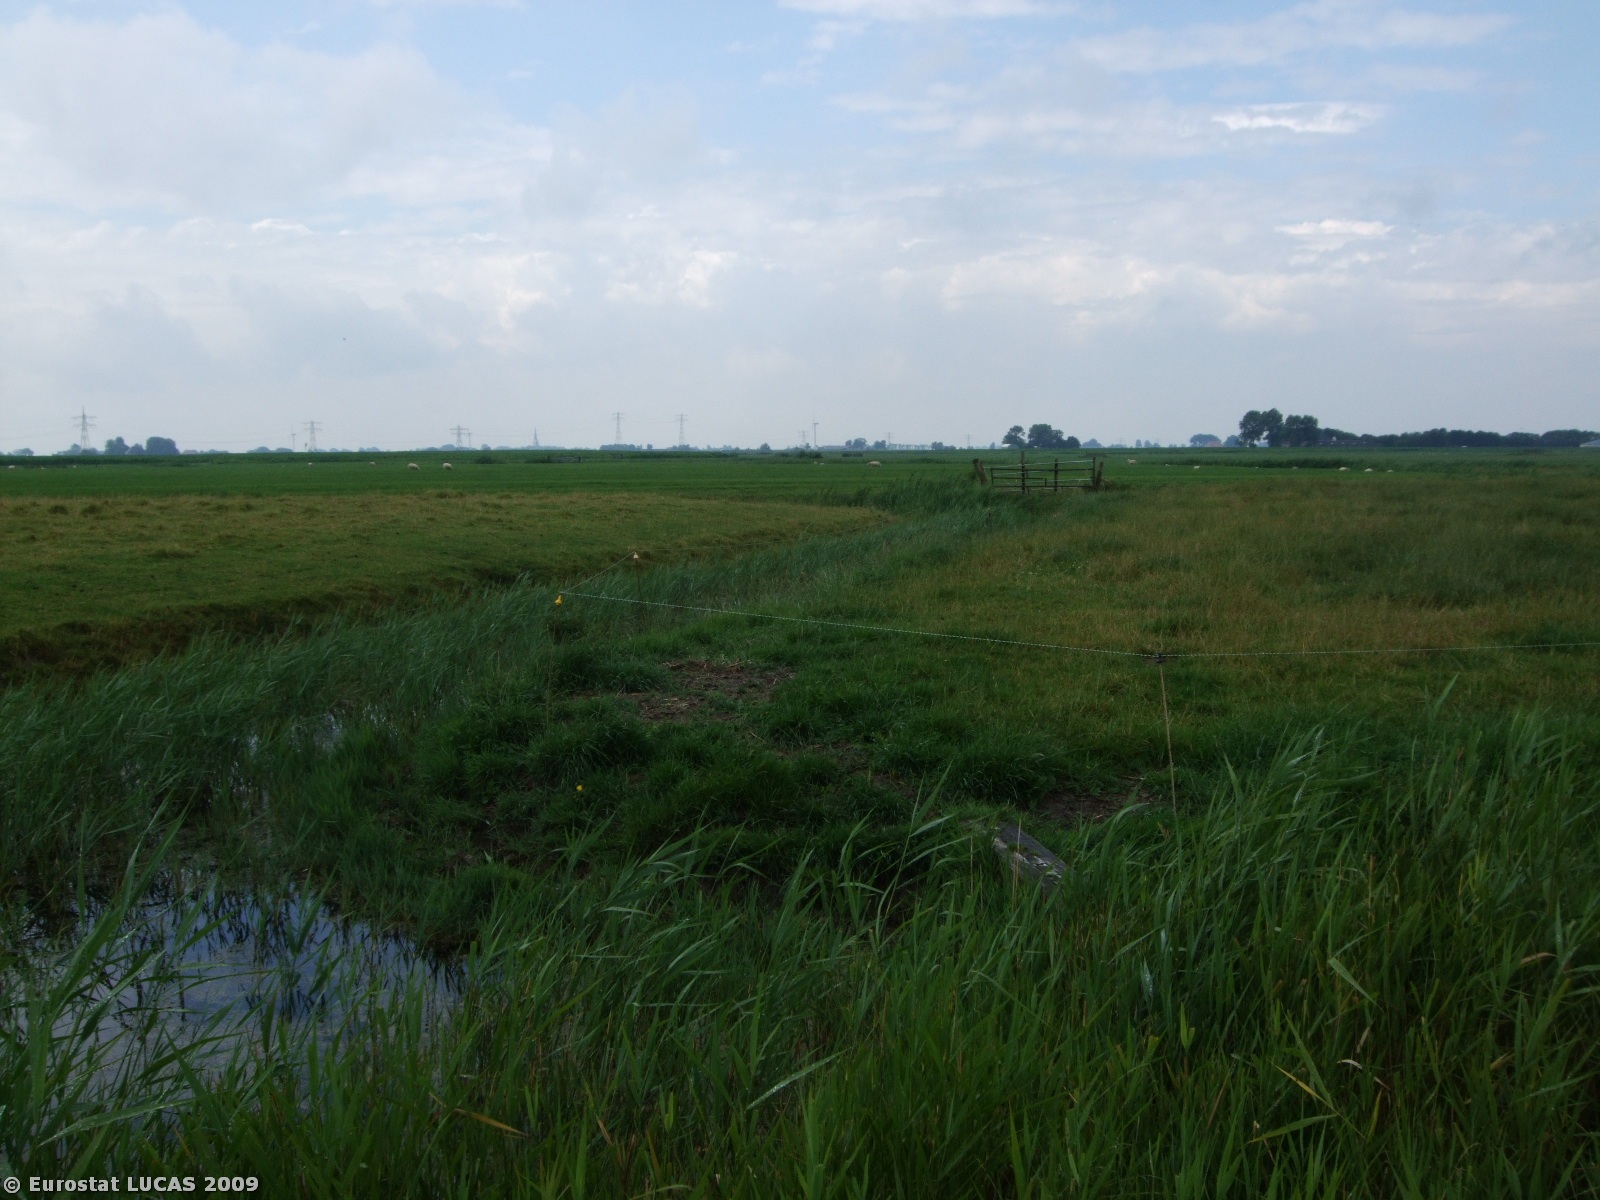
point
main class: Grassland
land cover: Grassland without tree/shrub cover
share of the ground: > 75 %
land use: Agriculture (excluding fallow land and kitchen gardens)
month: July
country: NL
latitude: 53.1786
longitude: 5.6149
